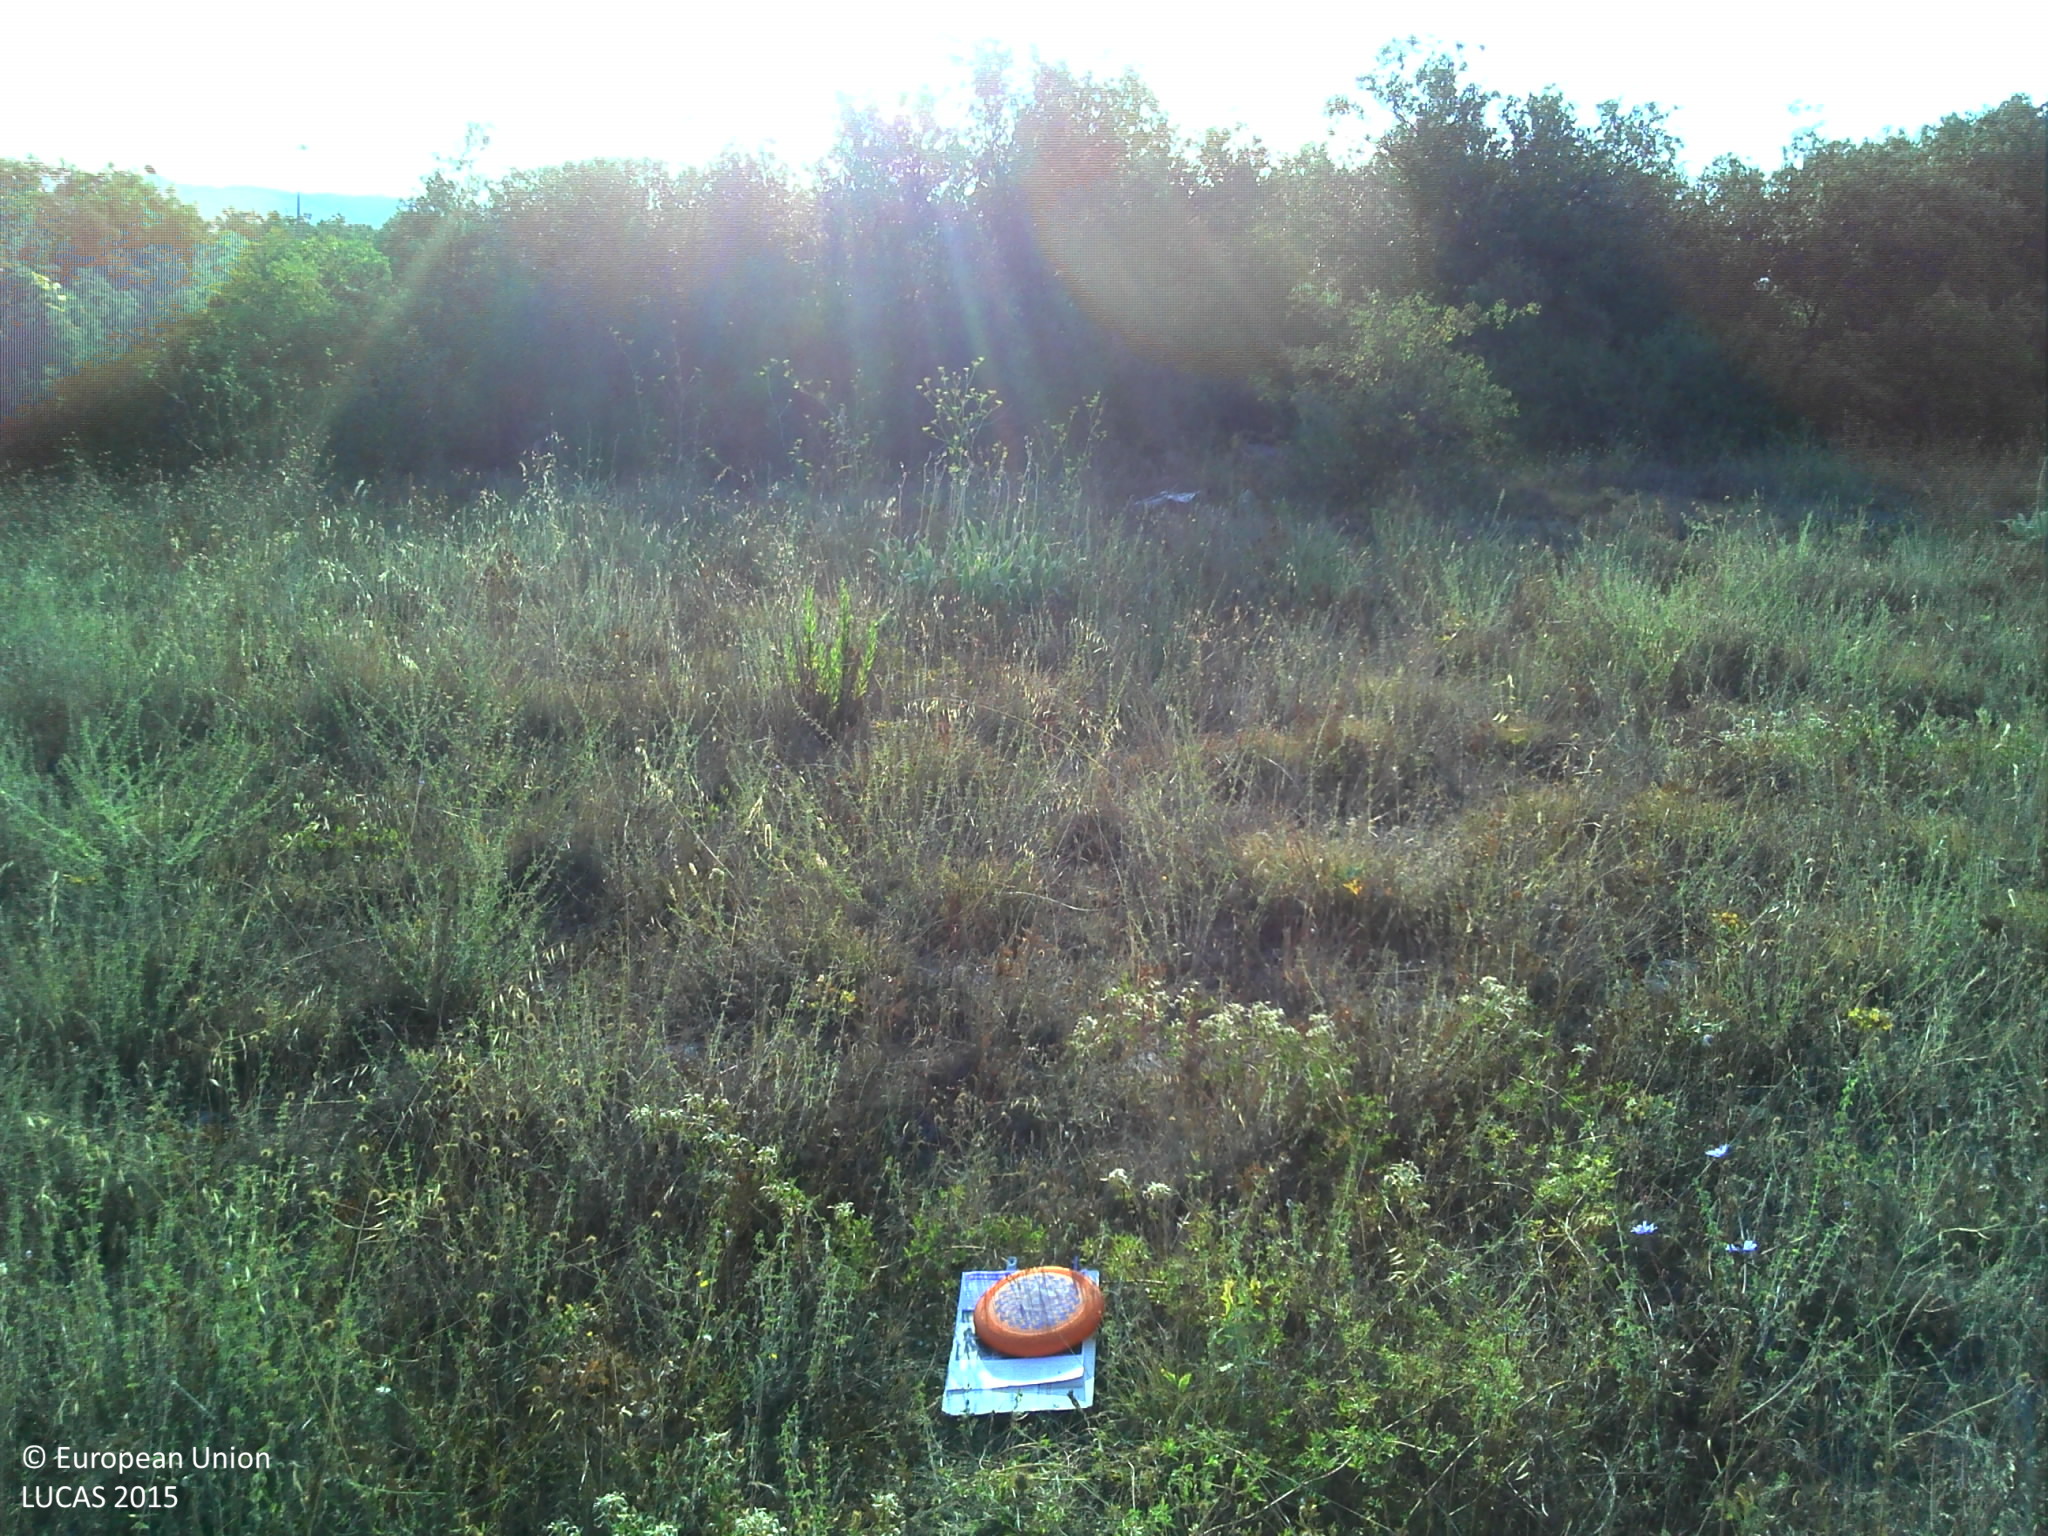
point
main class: Grassland
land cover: Spontaneously vegetated surfaces
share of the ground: > 75 %
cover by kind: herbaceous plants 80 %, unconsolidated bare surface 10 %, shrubs 5 %, lichens and mosses 5 %
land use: Semi-natural and natural areas not in use
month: August
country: FR
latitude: 43.8858
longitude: 5.3659
